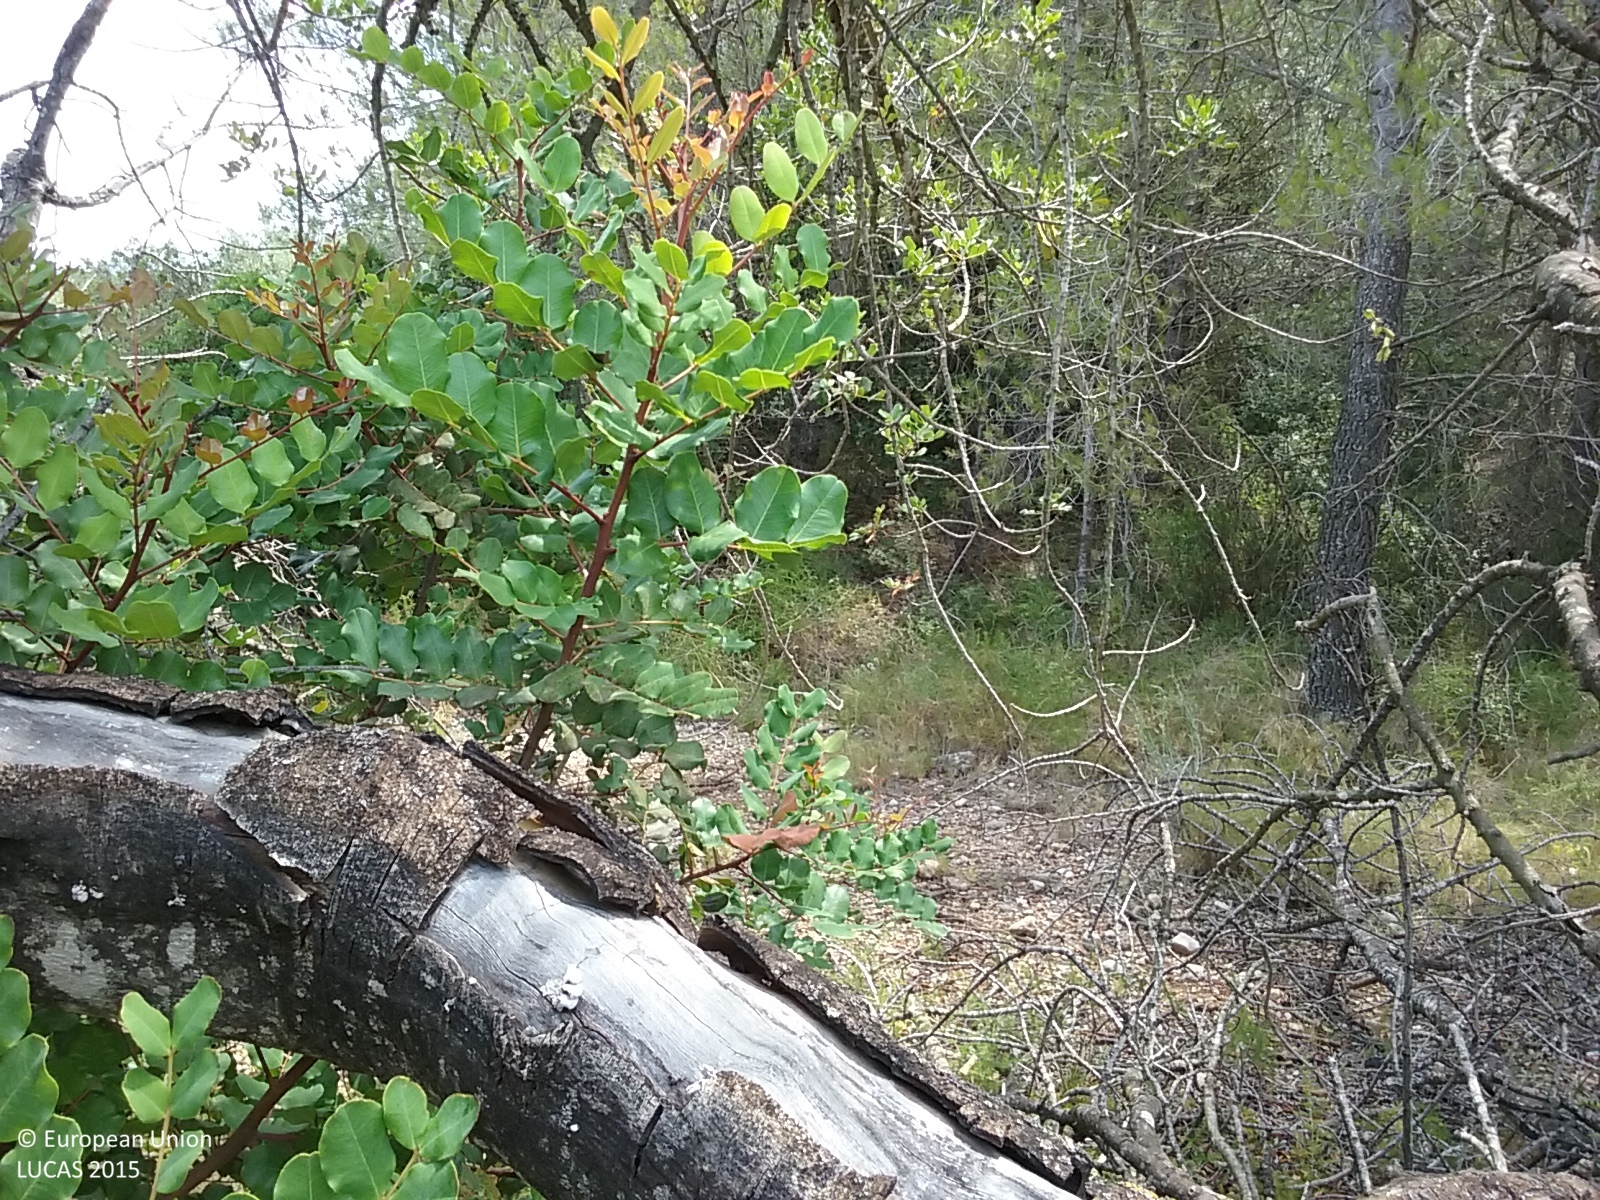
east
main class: Cropland
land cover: Permanent industrial crops
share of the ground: 10 - 25 %
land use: Abandoned areas
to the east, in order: Permanent industrial crops; Dry stone walls; Broadleaved woodland; Dry stone walls; Olive groves; Dry stone walls; Olive groves; Dry stone walls; Olive groves; Dry stone walls; Pine dominated coniferous woodland; Dry stone walls; Pine dominated coniferous woodland; Permanent industrial crops; Dry stone walls; Shruby margins; Tracks; Shruby margins; Dry stone walls; Permanent industrial crops; Shrubland with sparse tree cover; Dry stone walls; Pine dominated coniferous woodland; Dry stone walls; Pine dominated coniferous woodland; Dry stone walls; Pine dominated coniferous woodland
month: July
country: ES
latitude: 40.2570
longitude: -0.0799
